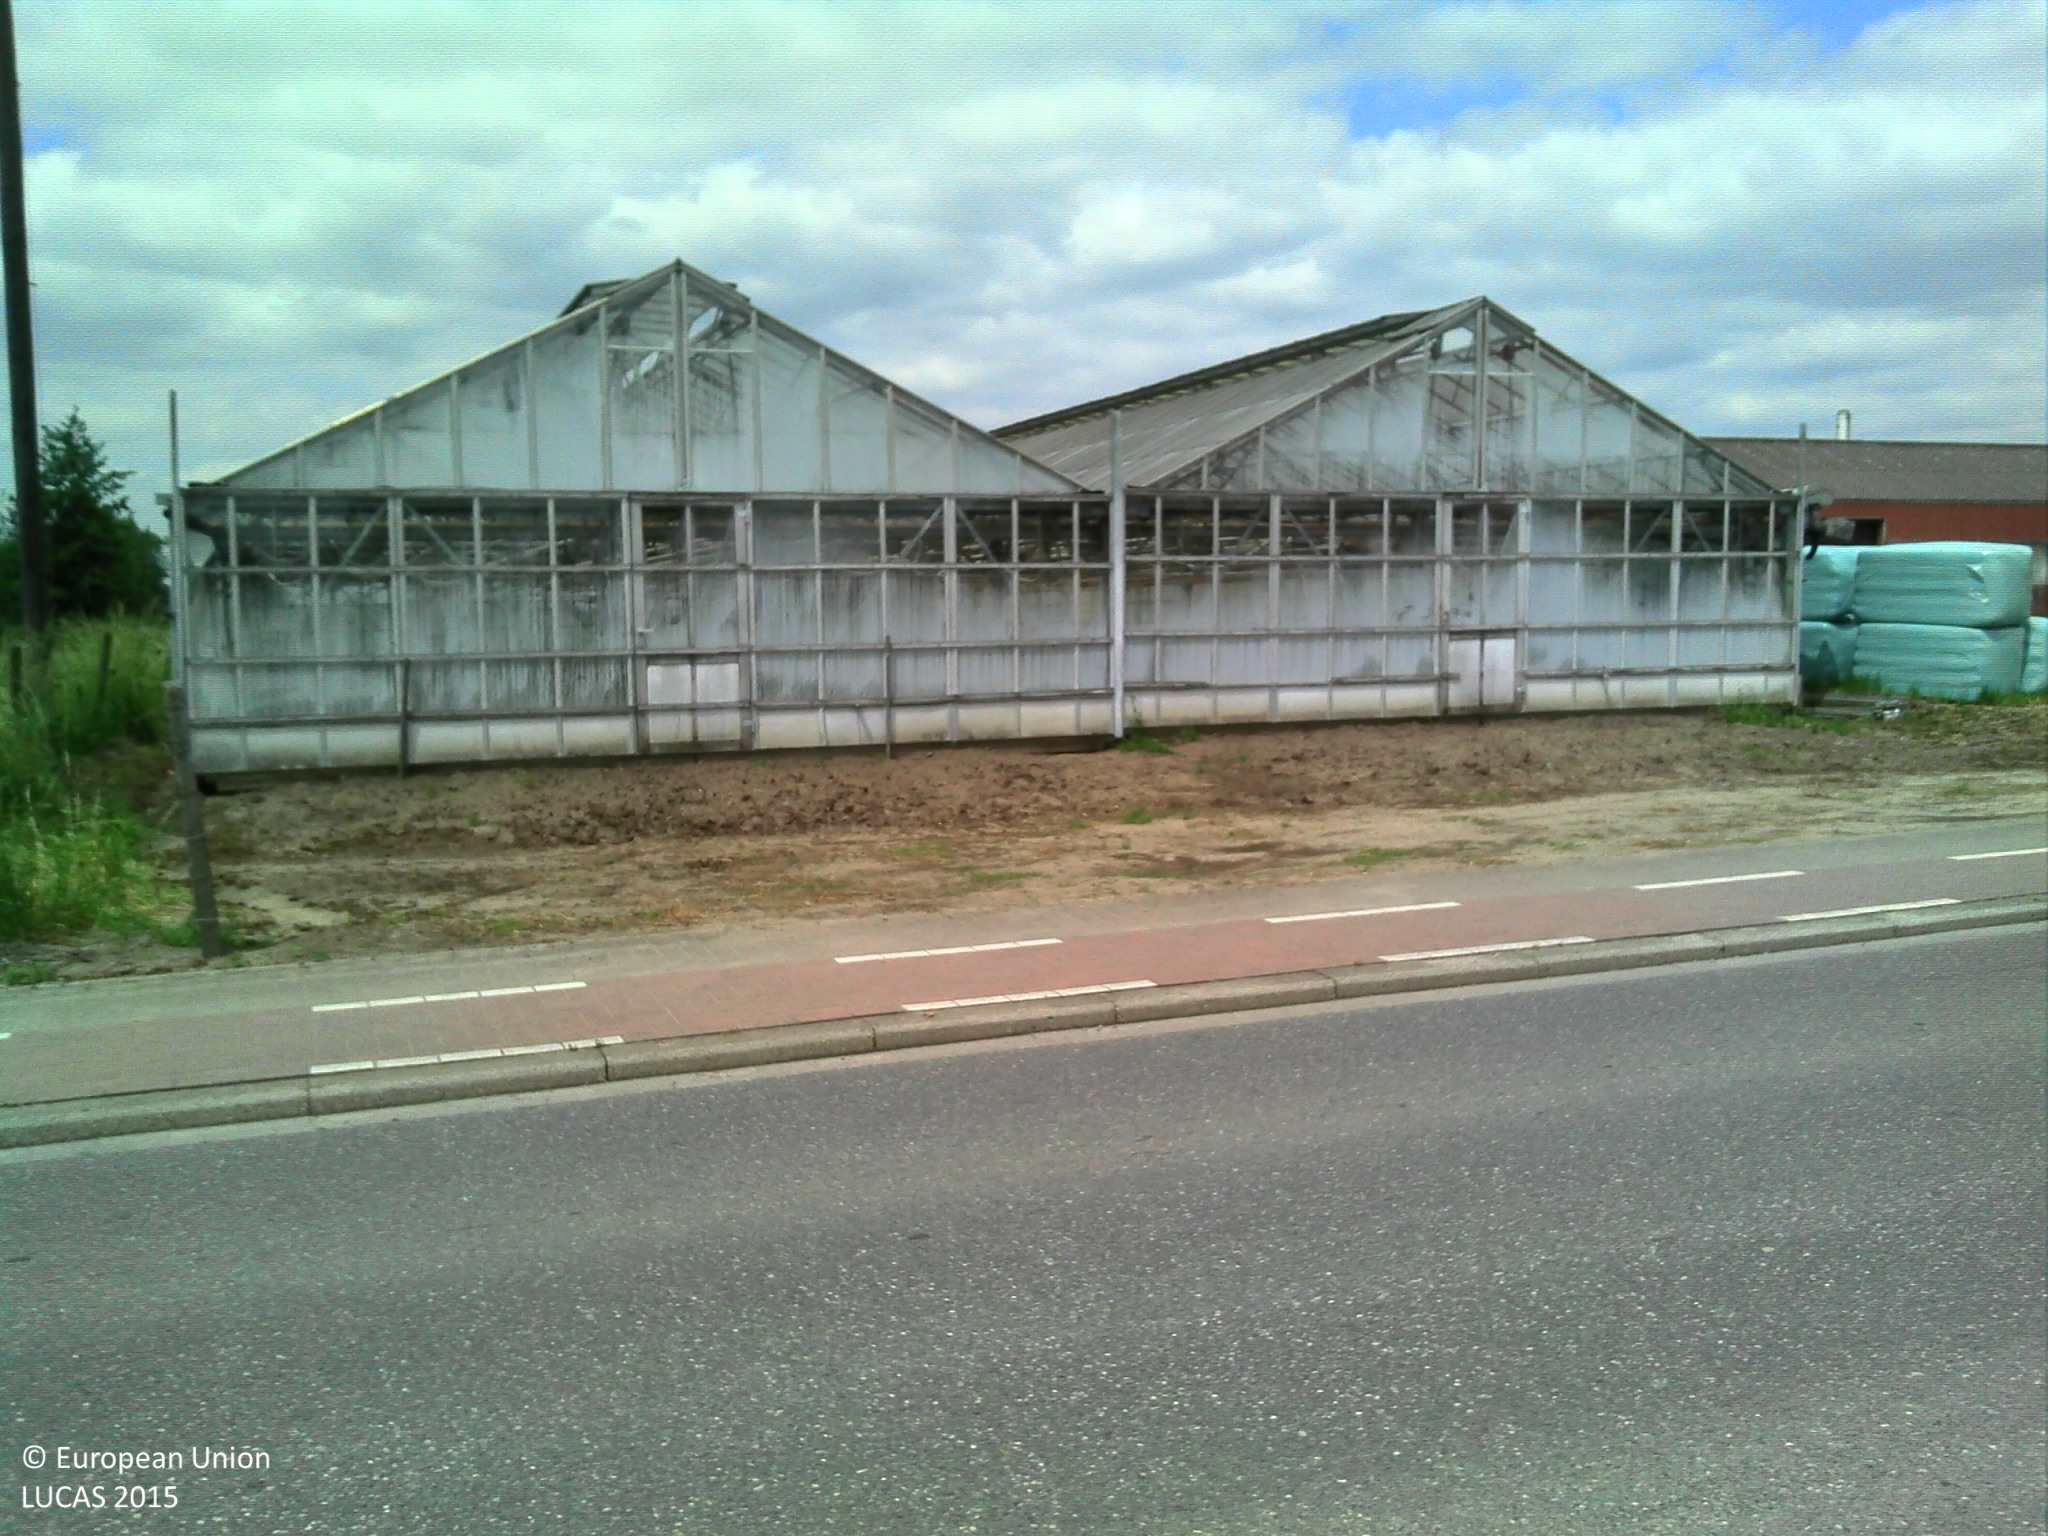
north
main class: Grassland
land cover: Grassland with sparse tree/shrub cover
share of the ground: > 75 %
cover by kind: herbaceous plants 95 %, broadleaved forest trees 5 %
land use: Agriculture (excluding fallow land and kitchen gardens)
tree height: < 5 m
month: June
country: BE
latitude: 50.9876
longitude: 4.1110
